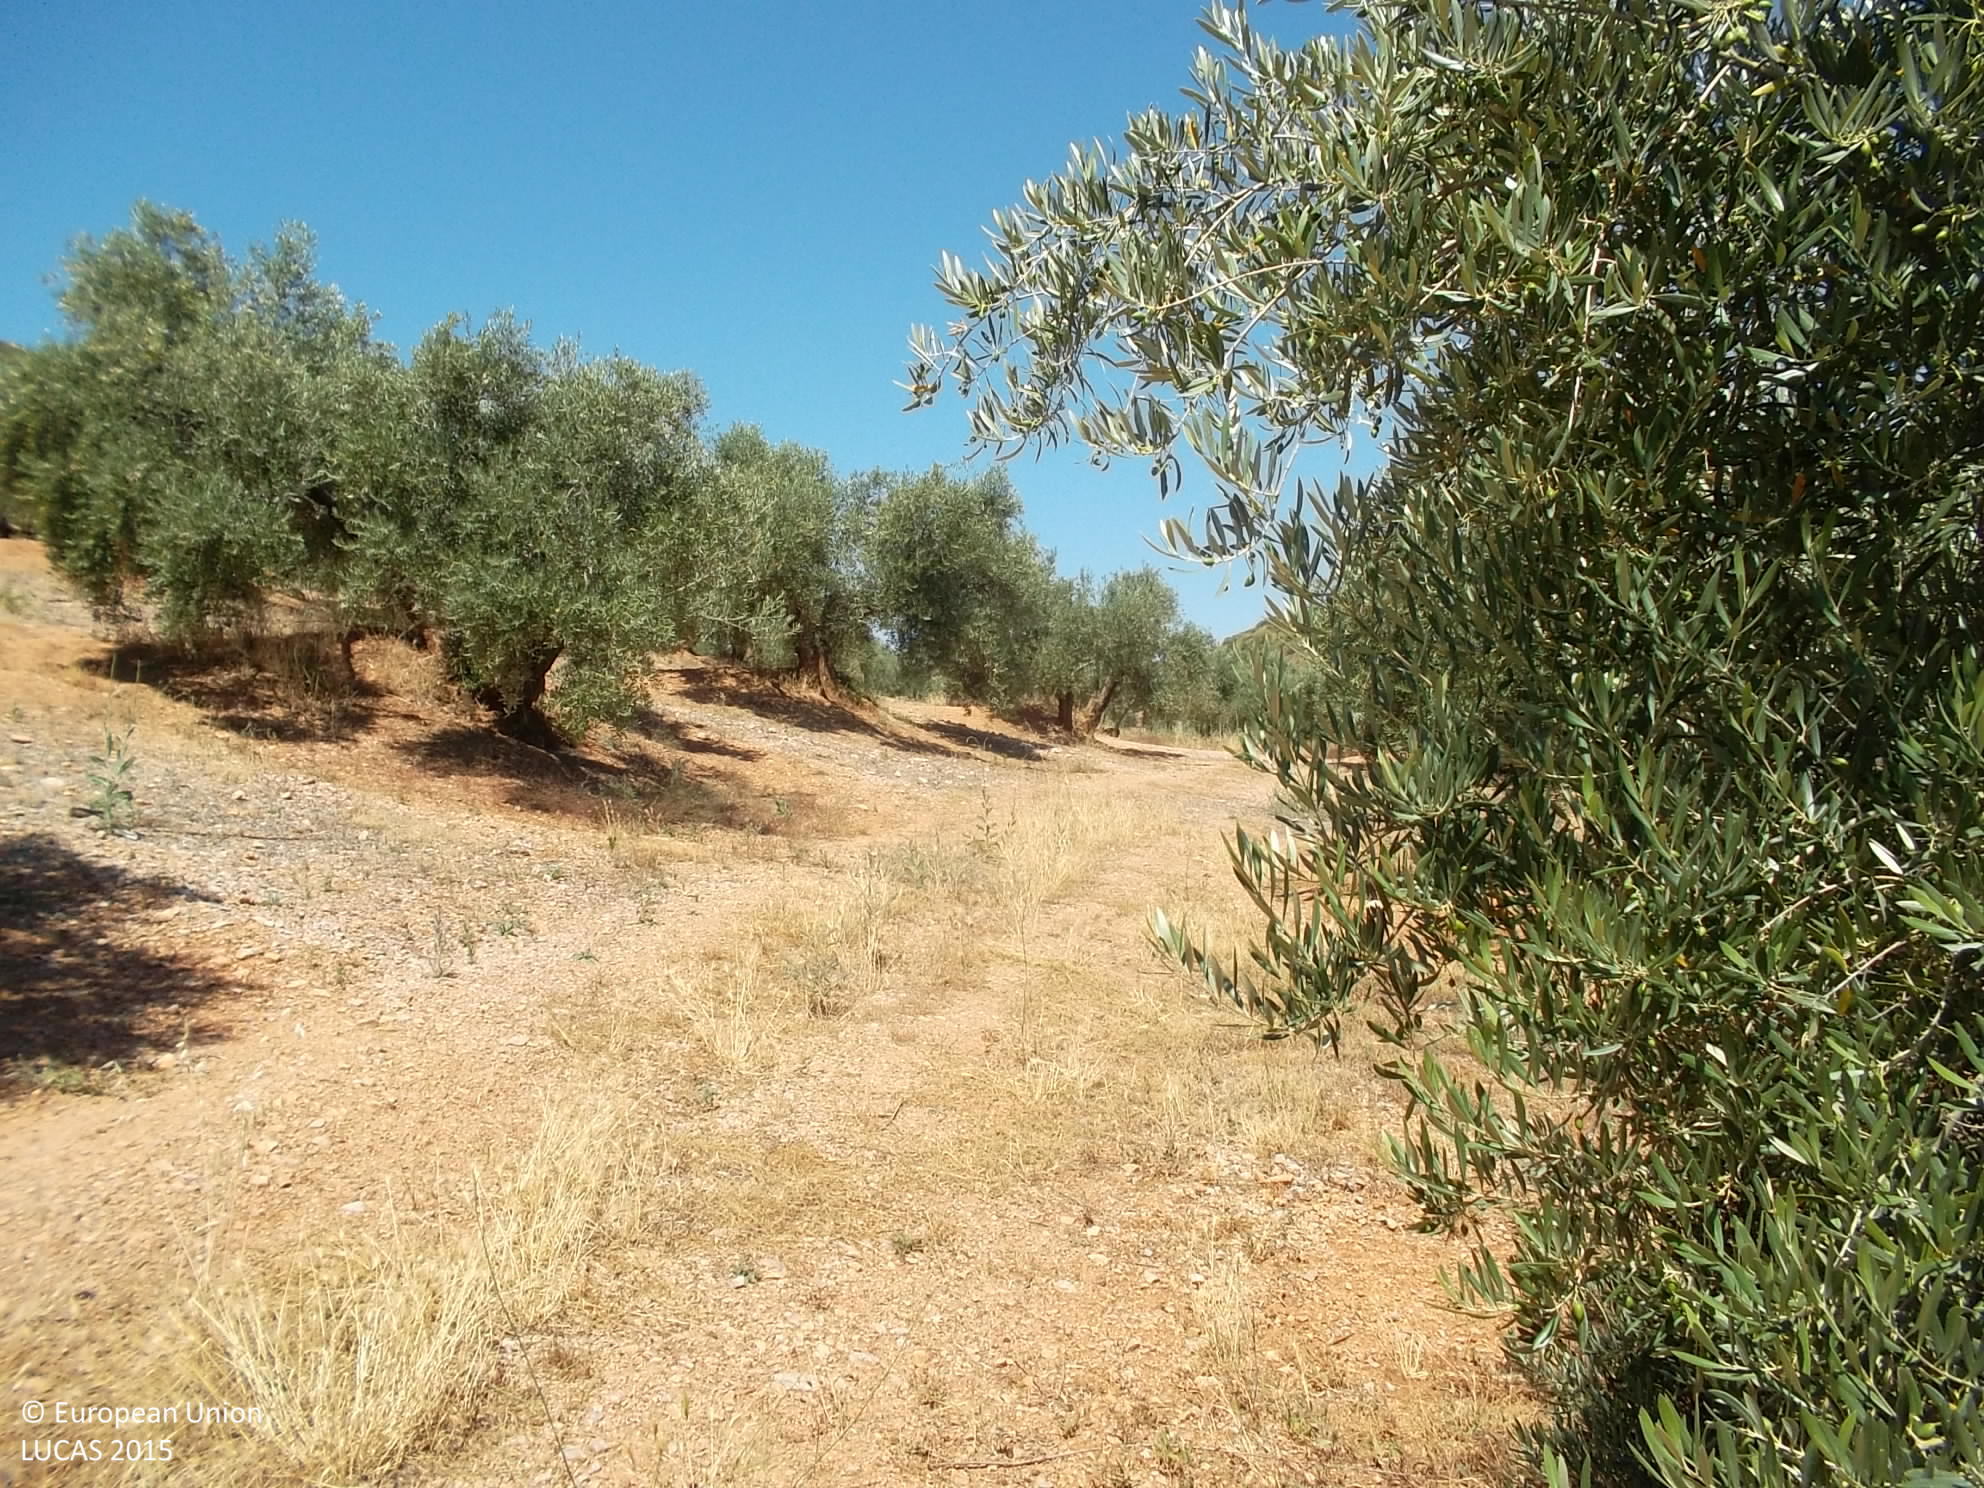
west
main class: Cropland
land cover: Olive groves
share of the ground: 25 - 50 %
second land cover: Spontaneously vegetated surfaces
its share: < 10 %
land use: Agriculture (excluding fallow land and kitchen gardens)
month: June
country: ES
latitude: 37.7940
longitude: -3.3400
